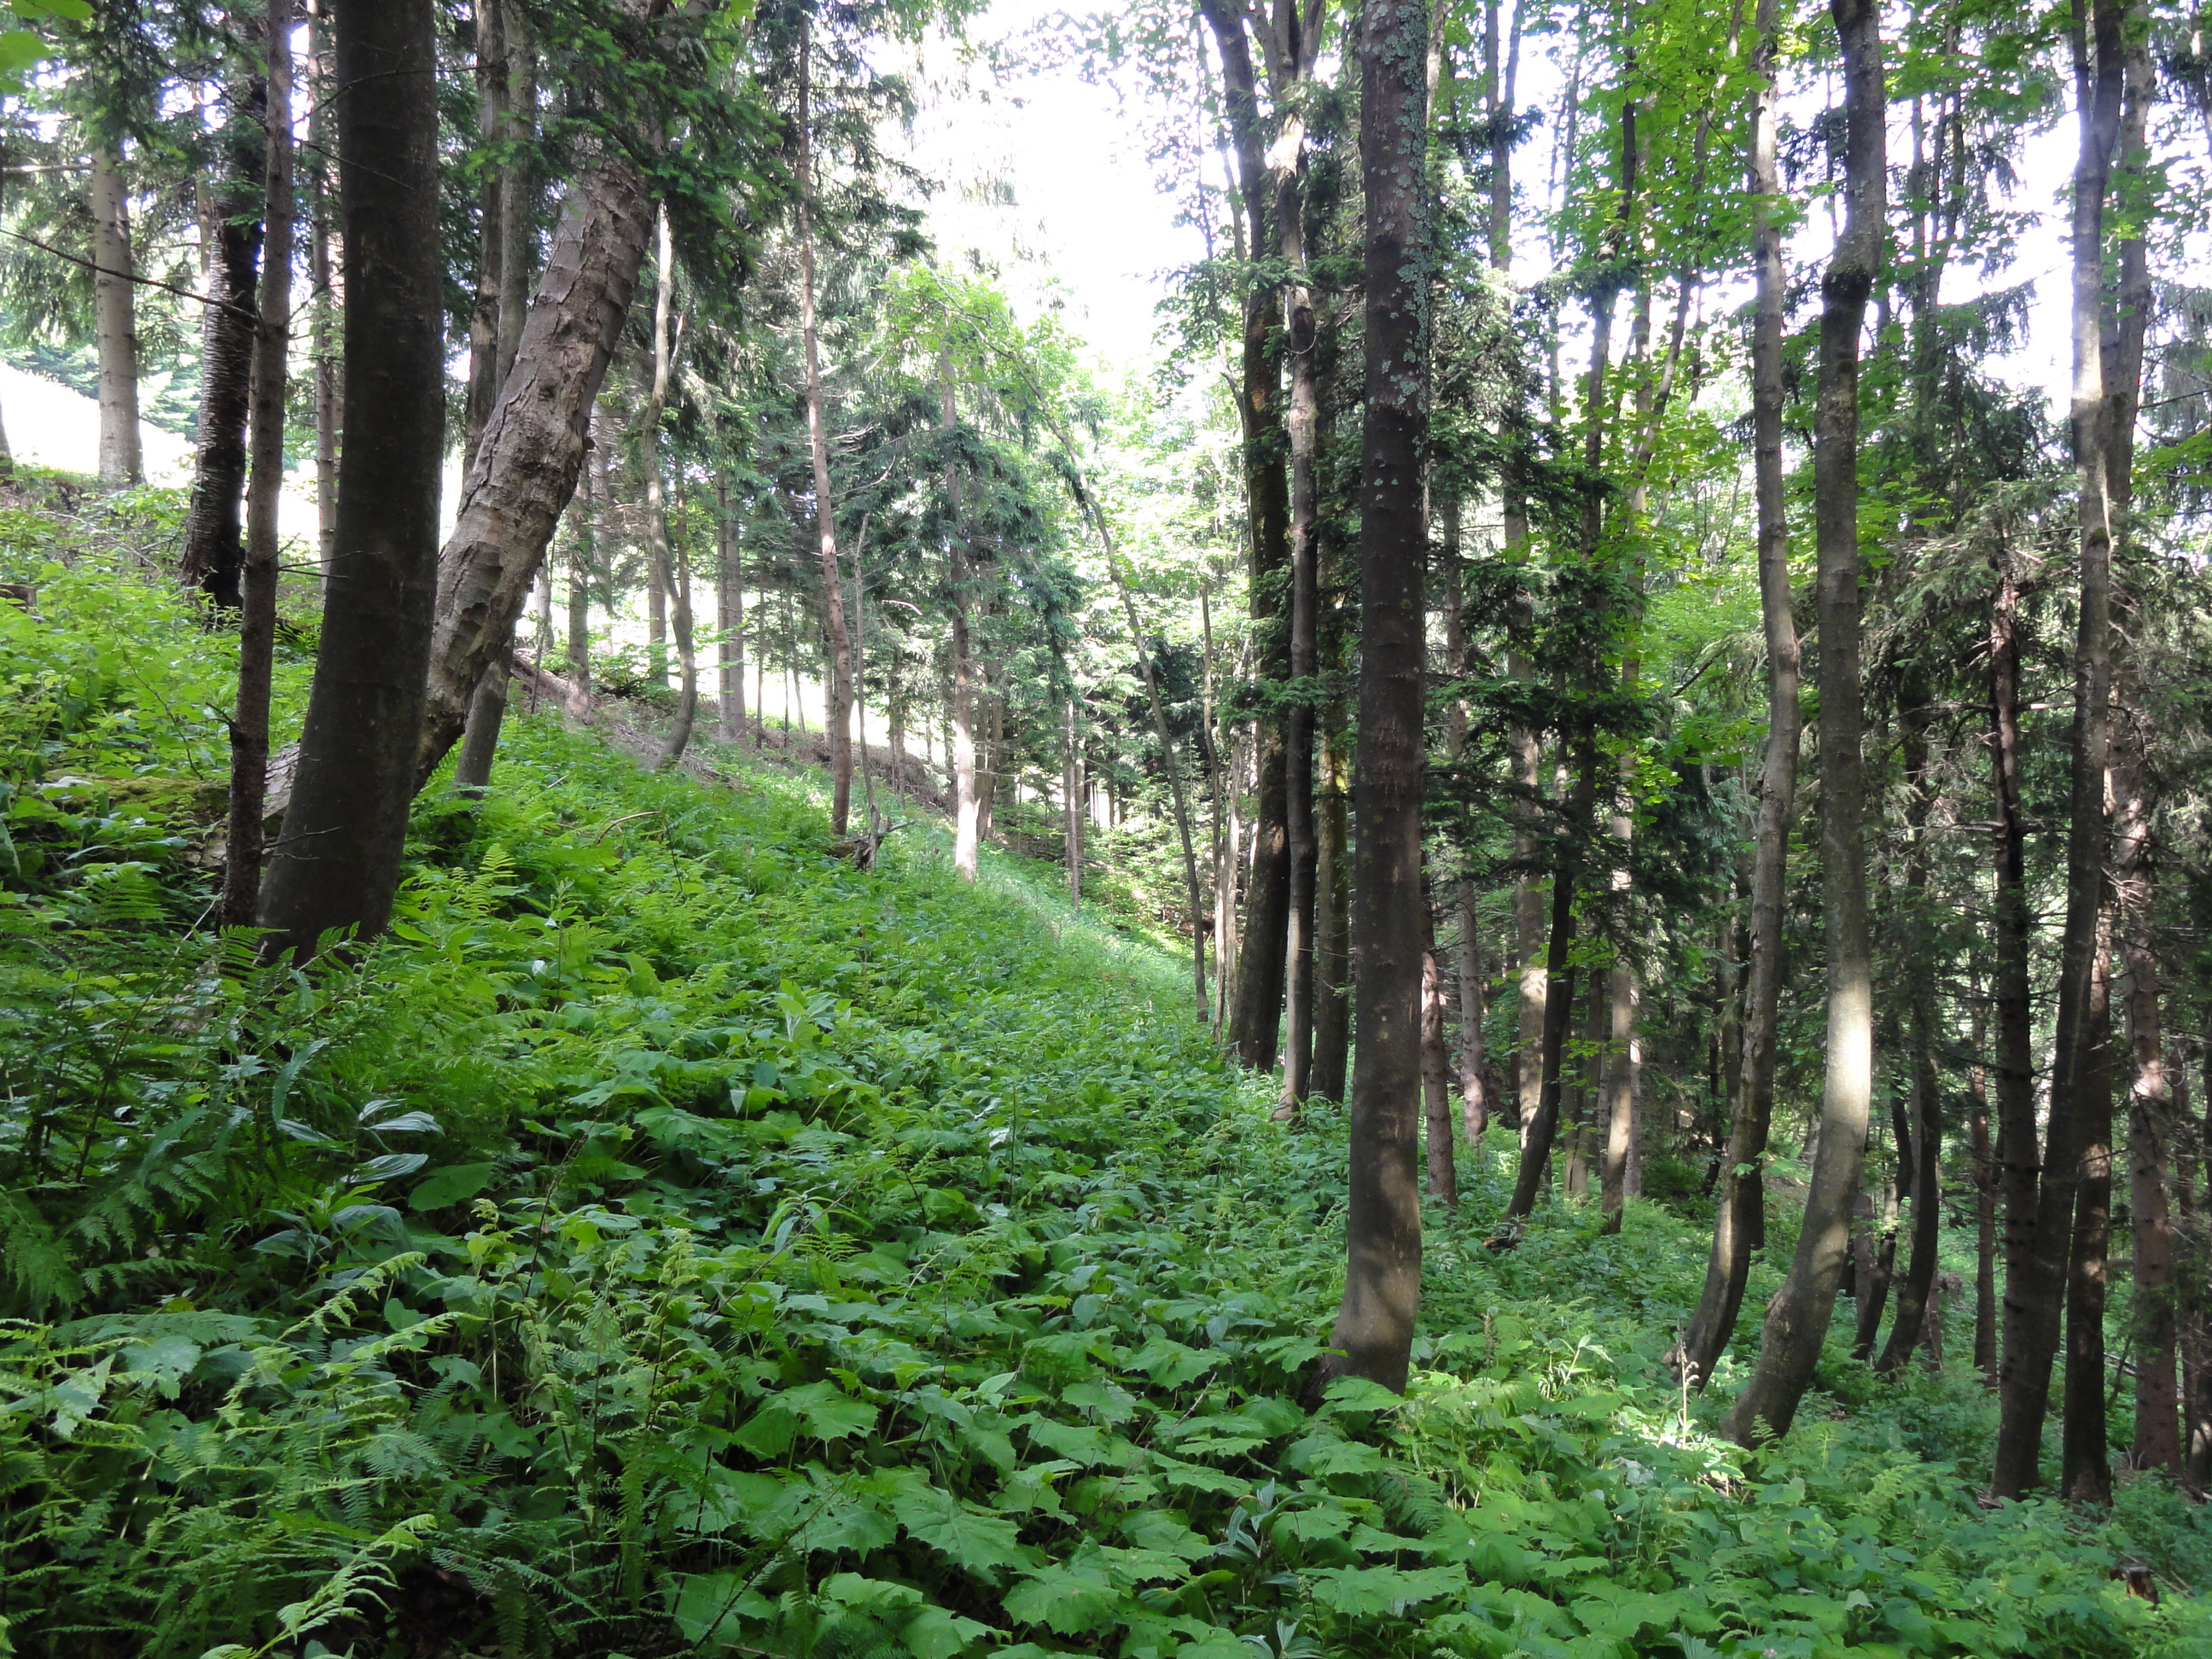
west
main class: Woodland
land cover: Spruce dominated mixed woodland
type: mountainous beech forest
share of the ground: > 75 %
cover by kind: coniferous forest trees 50 %, broadleaved forest trees 50 %
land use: Forestry
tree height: > 5 m
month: June
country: SI
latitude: 46.2132
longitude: 15.0656
